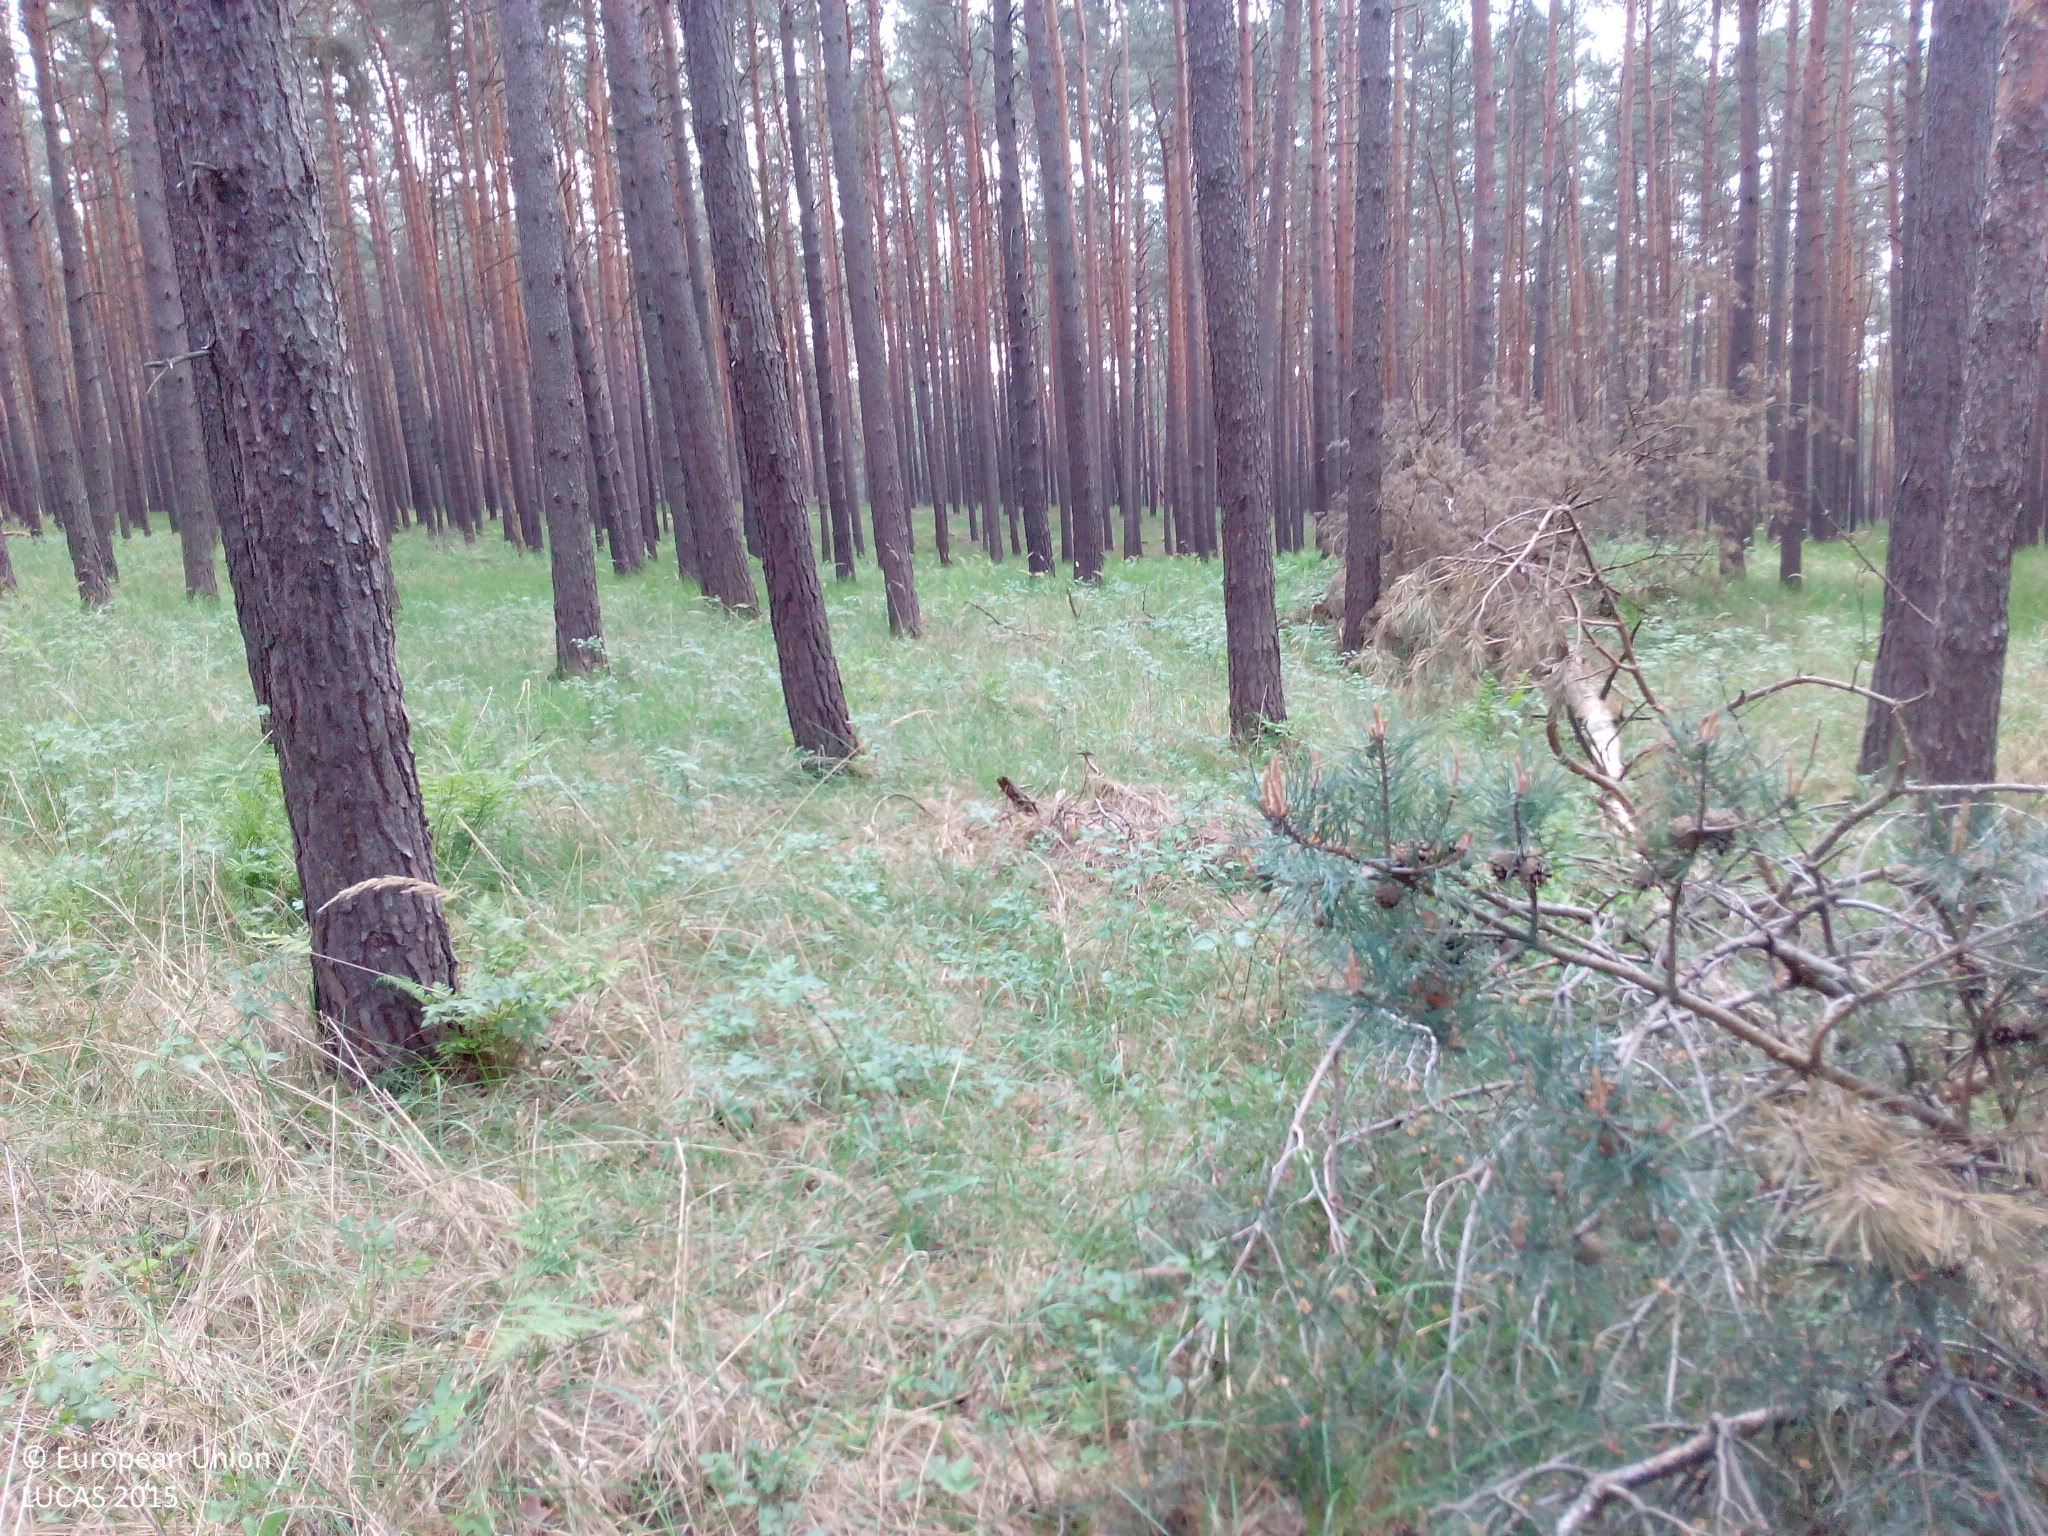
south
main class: Woodland
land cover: Pine dominated coniferous woodland
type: hemiboreal forest and nemoral coniferous forest and mixed broadleaved-coniferous forest
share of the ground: > 75 %
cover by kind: coniferous forest trees 90 %, shrubs 5 %, herbaceous plants 5 %
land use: Forestry
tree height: > 5 m
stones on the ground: < 10 %
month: May
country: DE
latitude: 52.0623
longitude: 12.5523
